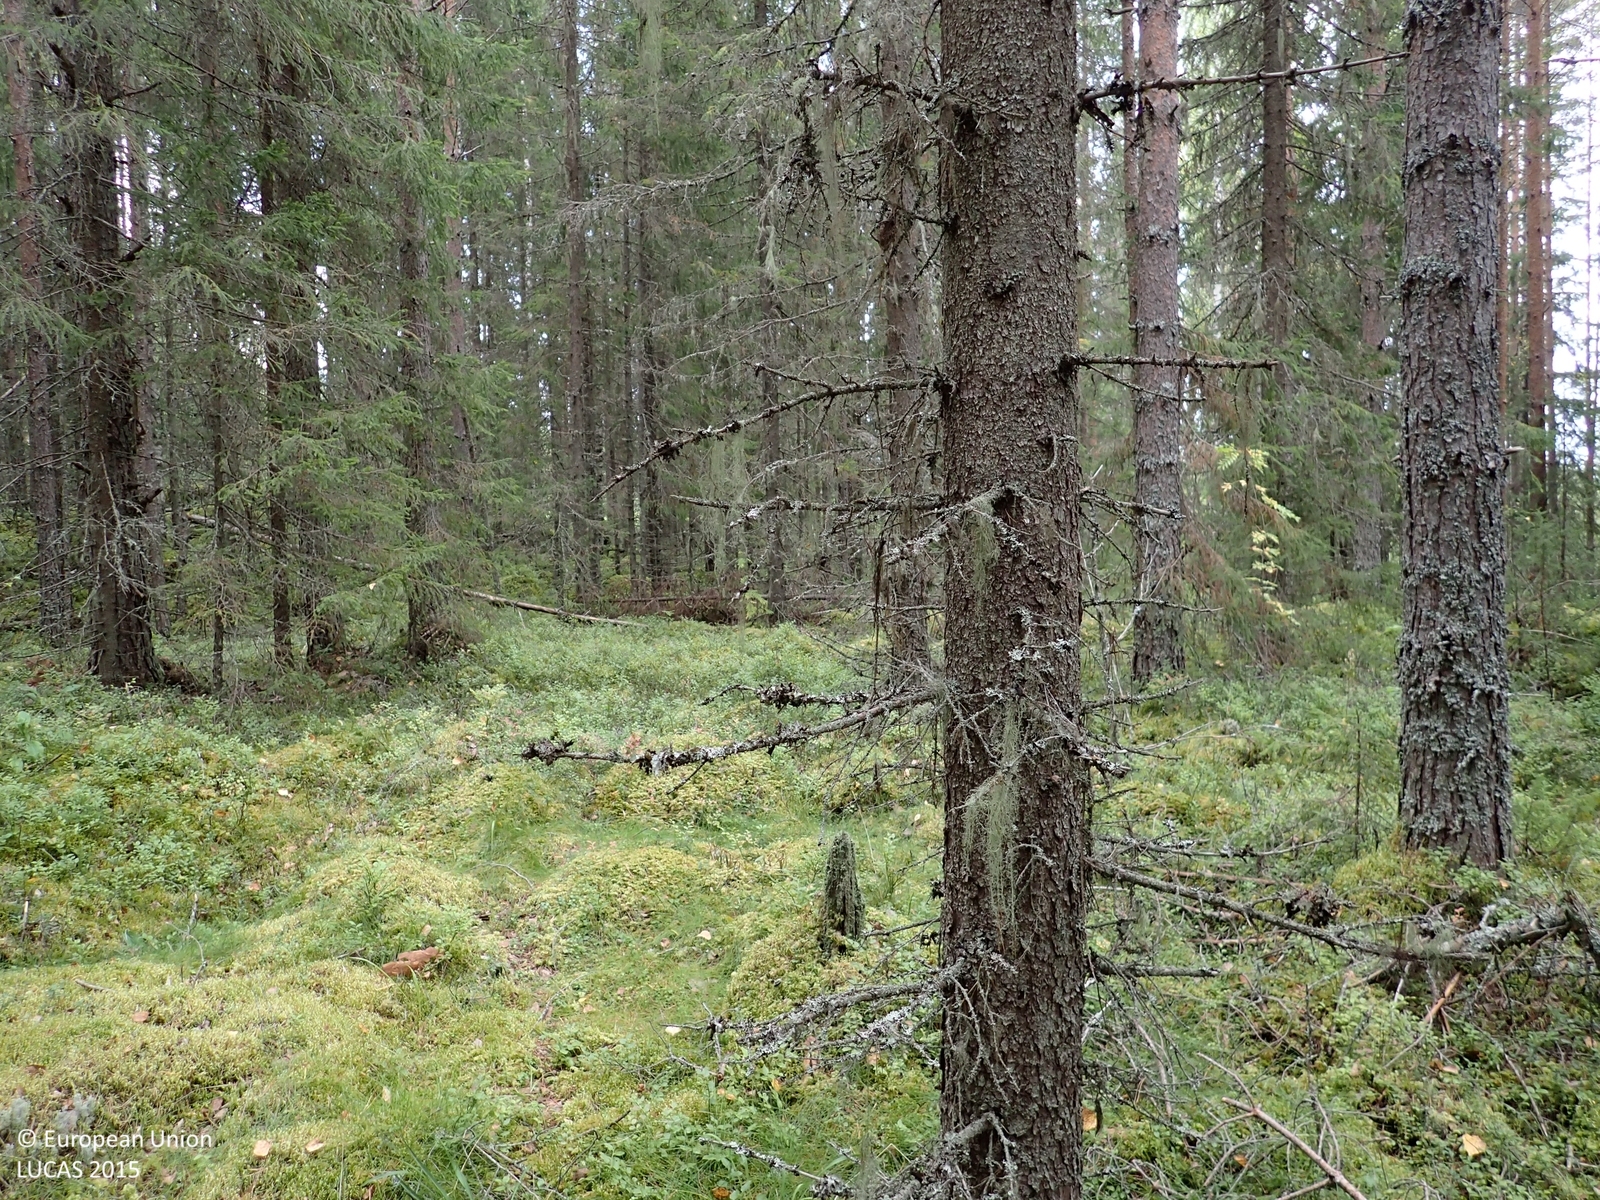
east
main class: Woodland
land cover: Other coniferous woodland
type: boreal forest
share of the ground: > 75 %
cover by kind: coniferous forest trees 70 %, broadleaved forest trees 10 %, shrubs 10 %, lichens and mosses 10 %
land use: Forestry
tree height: > 5 m
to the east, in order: Other coniferous woodland; Other mixed woodland; Spruce dominated mixed woodland; Other mixed woodland; Other coniferous woodland
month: September
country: FI
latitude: 62.9616
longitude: 25.7089
